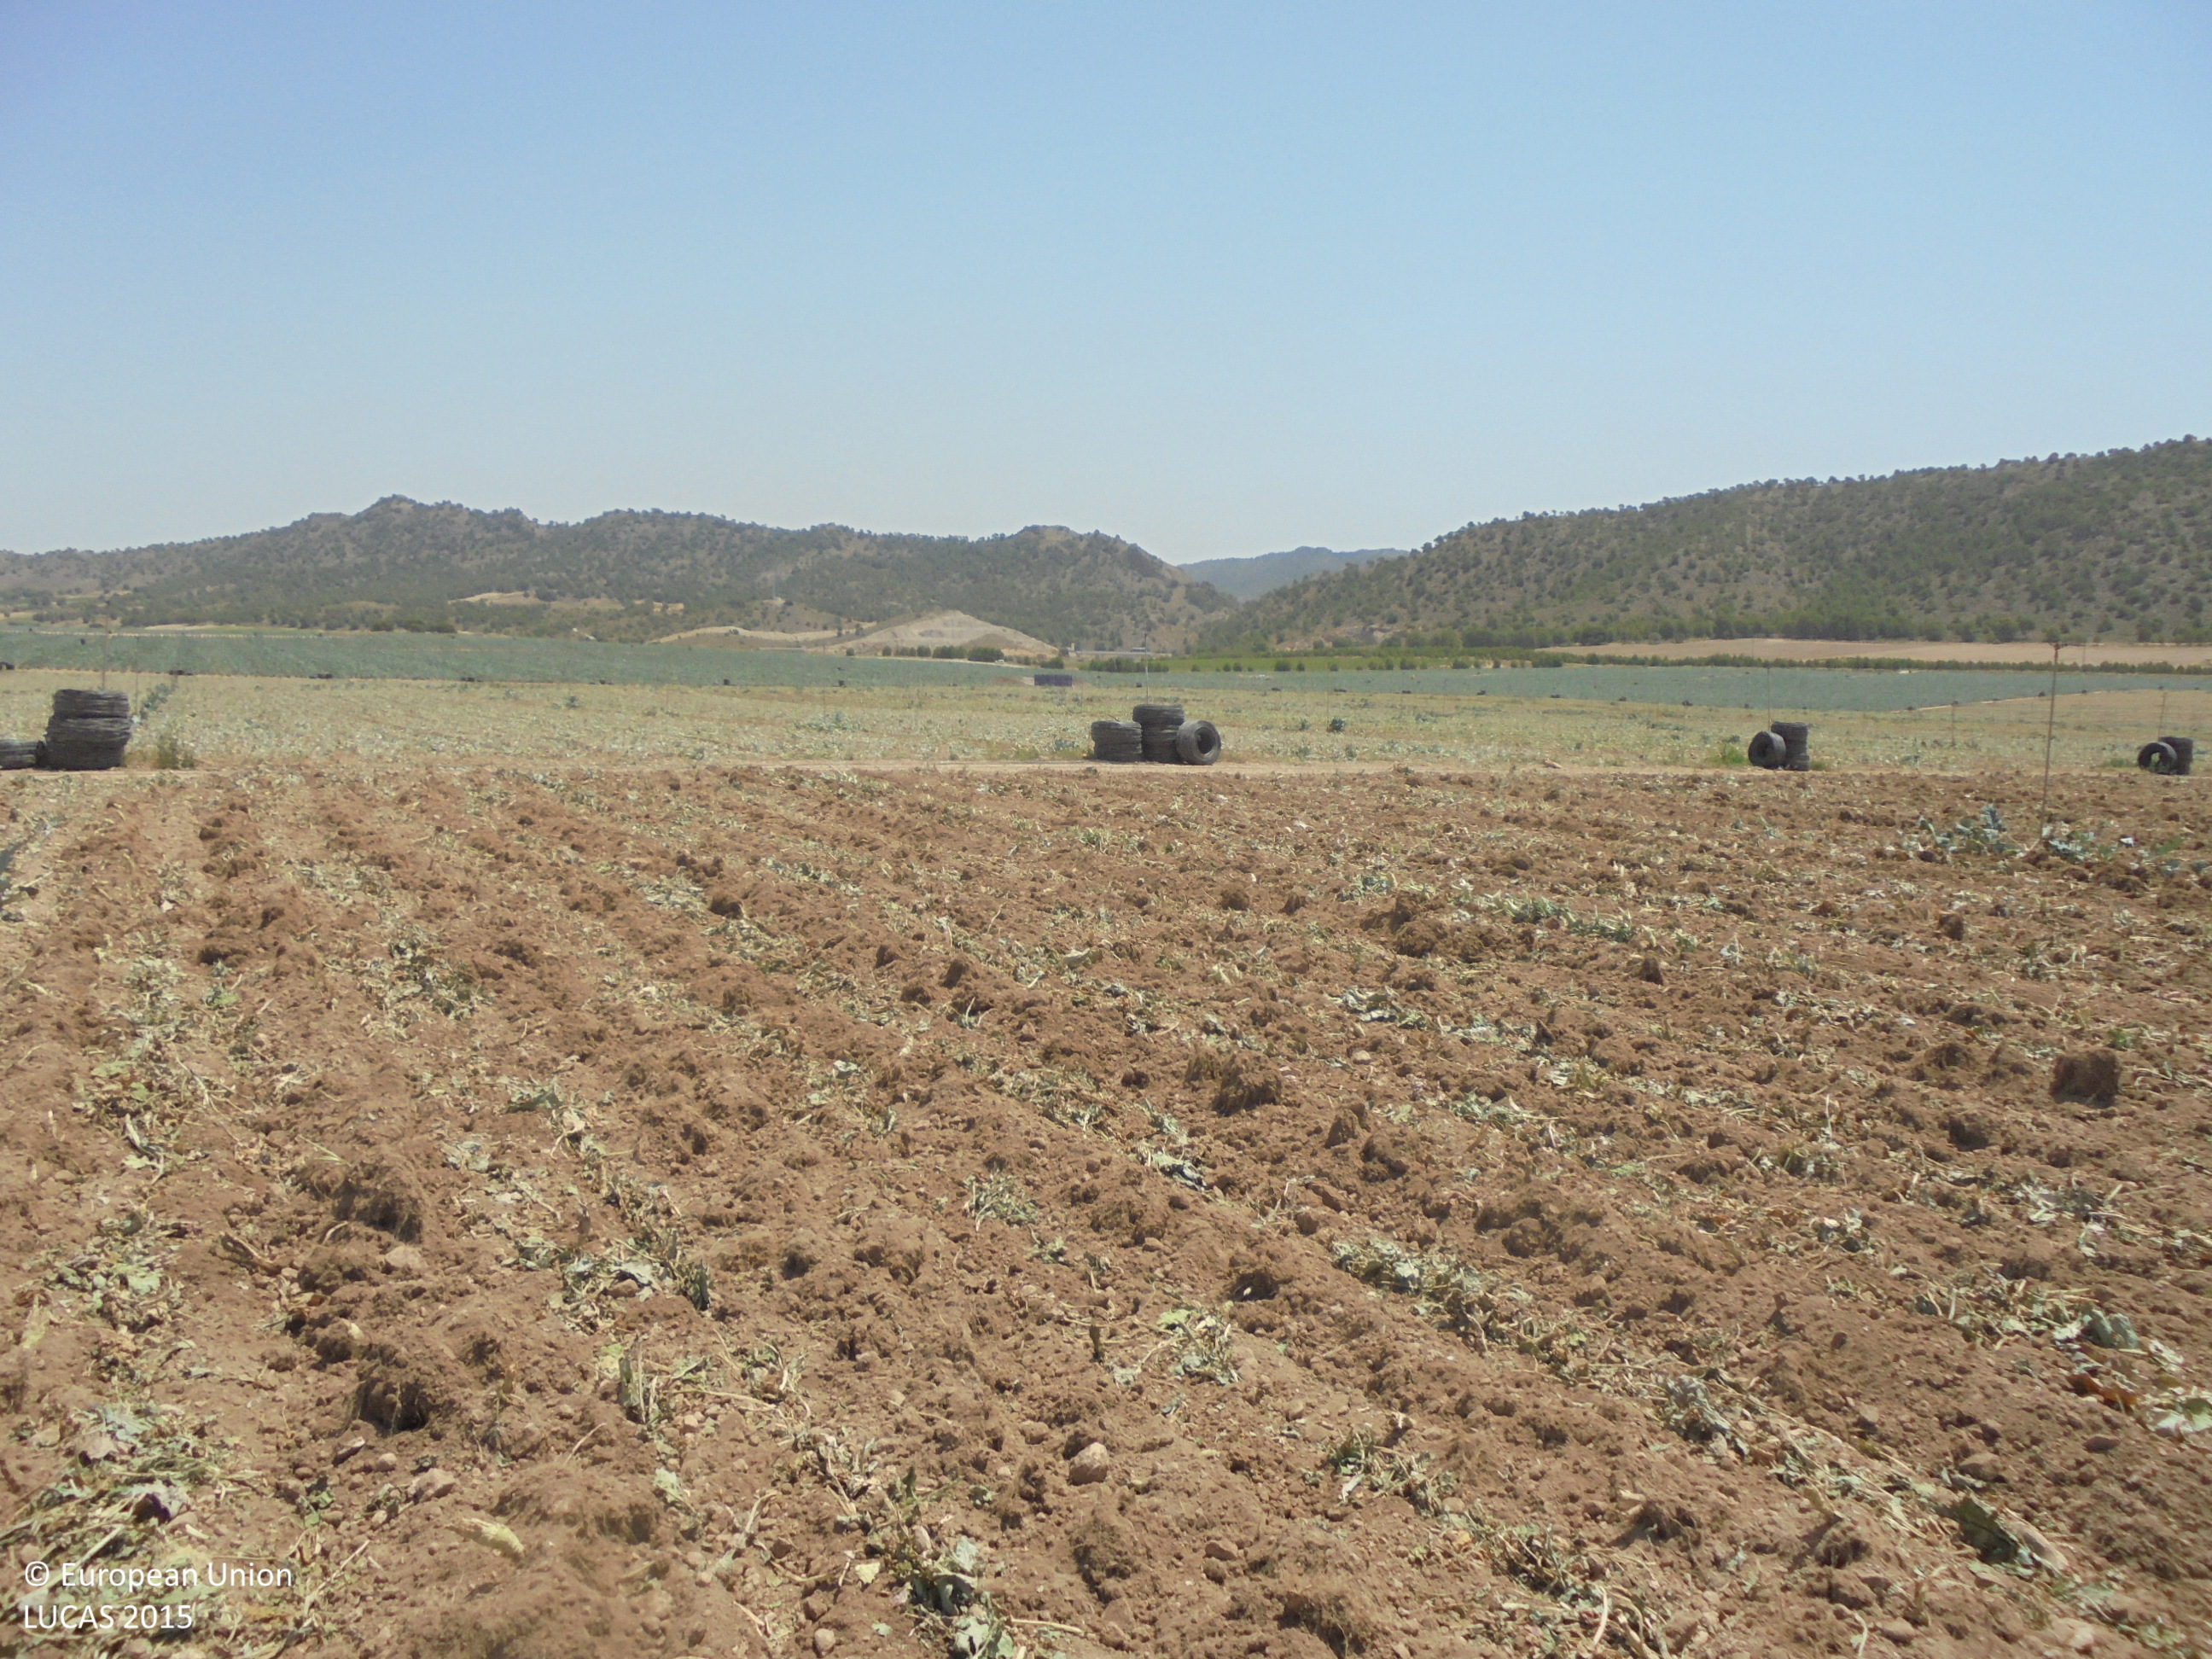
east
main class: Cropland
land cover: Other fresh vegetables
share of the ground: < 10 %
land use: Agriculture (excluding fallow land and kitchen gardens)
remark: Harvested field
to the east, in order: Other fresh vegetables; Tracks; Grass margins; Other fresh vegetables
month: July
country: ES
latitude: 38.6712
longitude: -1.6843
